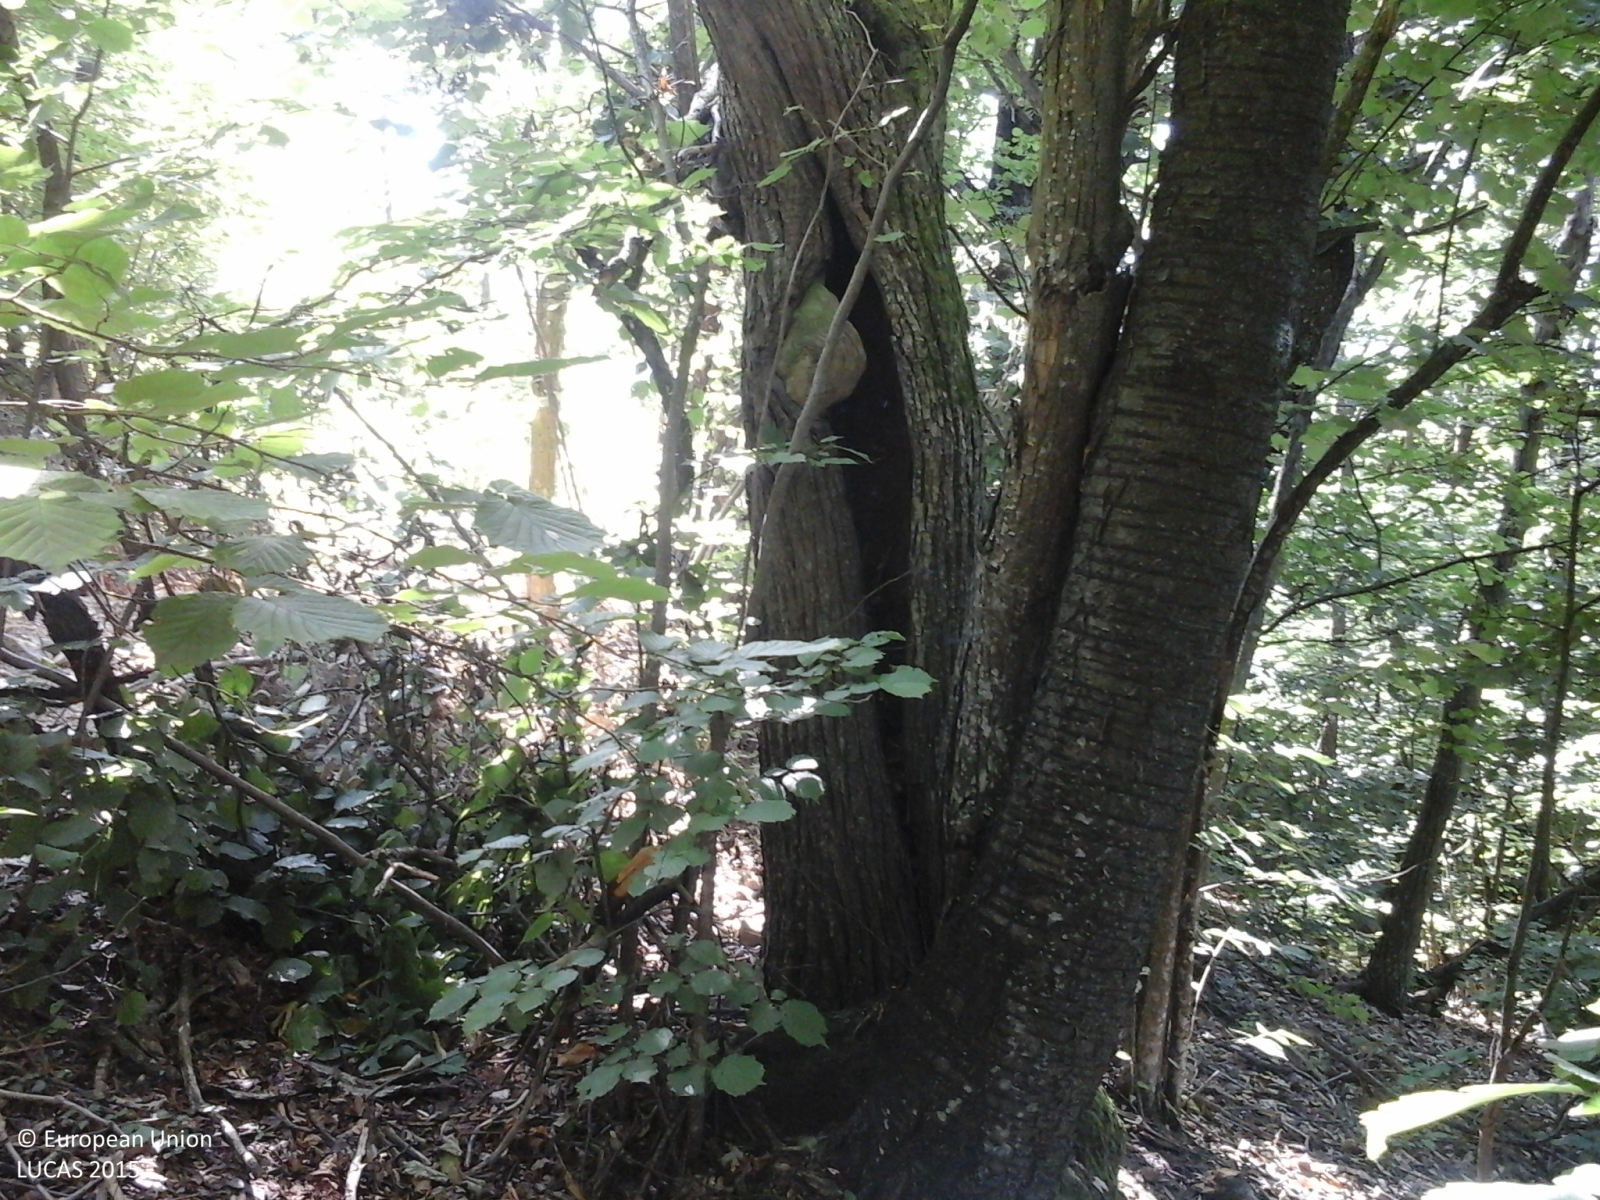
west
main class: Woodland
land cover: Broadleaved woodland
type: thermophilous deciduous forest
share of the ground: > 75 %
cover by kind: broadleaved forest trees 100 %
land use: Forestry
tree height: > 5 m
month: June
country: IT
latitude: 44.5884
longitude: 8.2528
